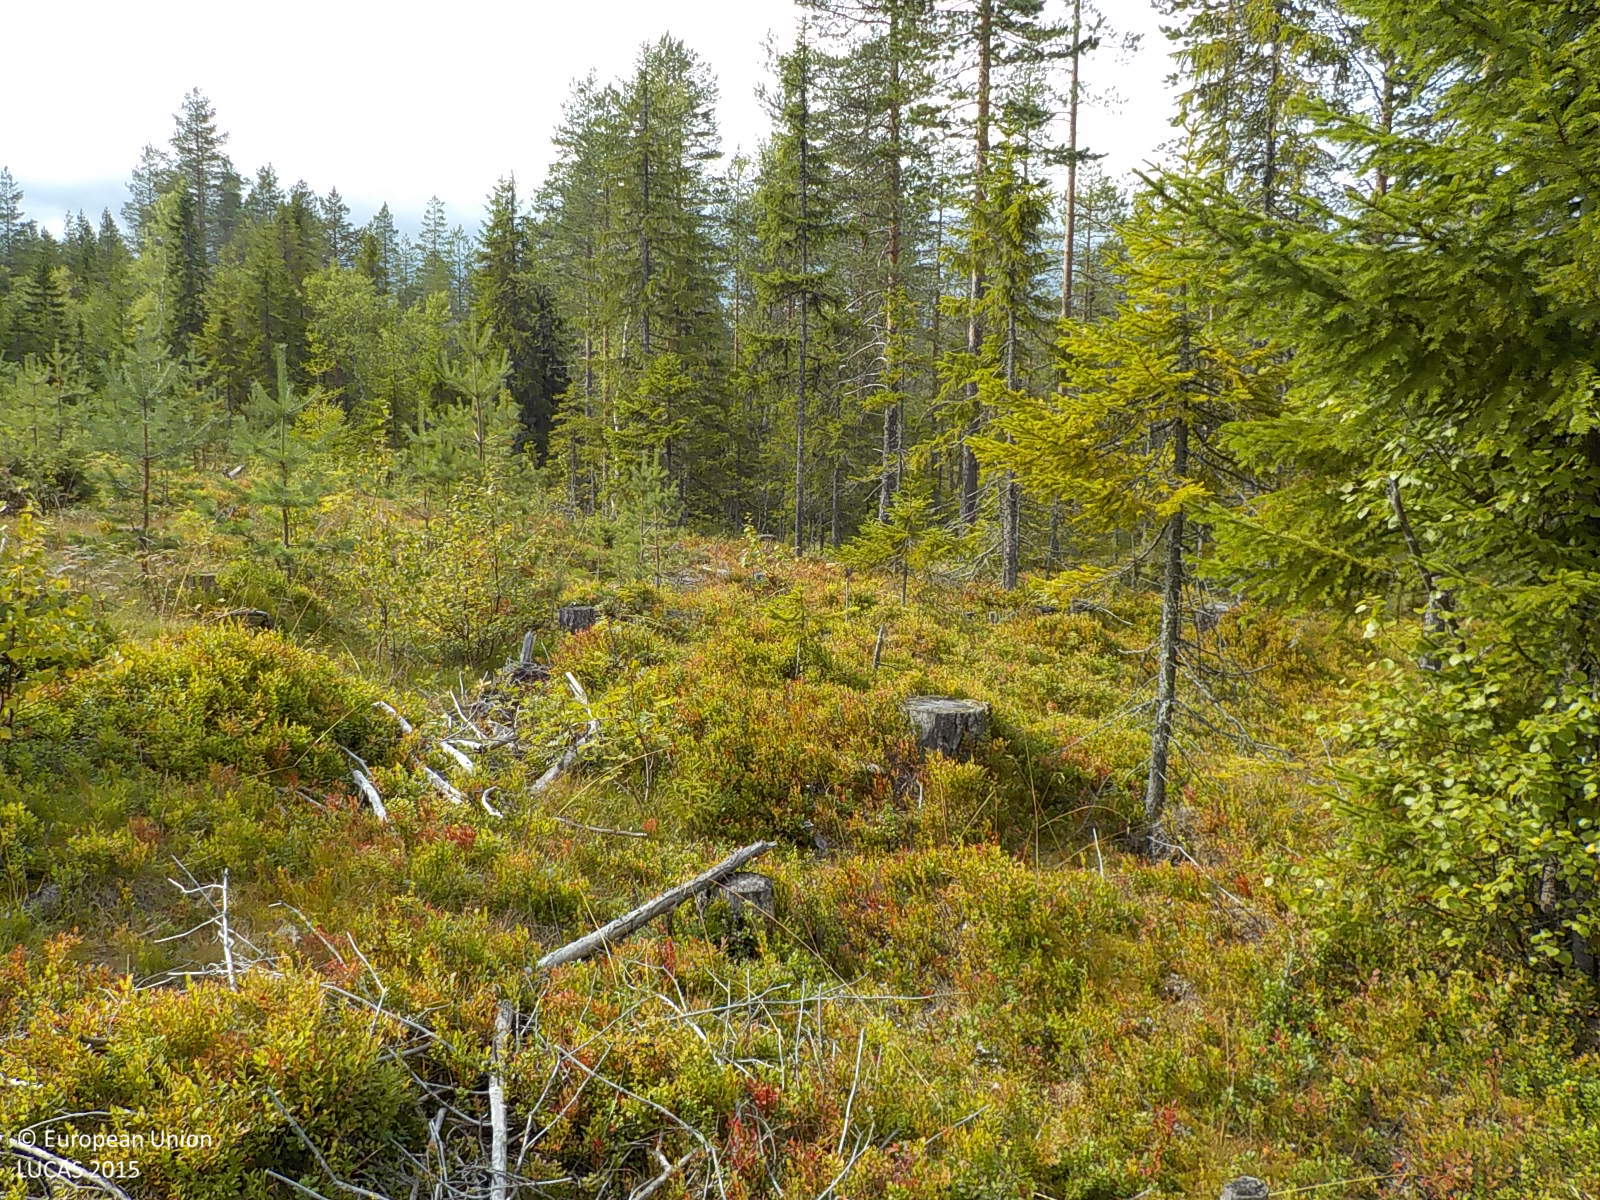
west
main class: Woodland
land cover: Spruce dominated coniferous woodland
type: boreal forest
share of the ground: > 75 %
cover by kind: coniferous forest trees 70 %, shrubs 20 %, broadleaved forest trees 5 %, herbaceous plants 5 %
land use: Forestry
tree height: > 5 m
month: September
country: SE
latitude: 63.3159
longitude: 17.8197
